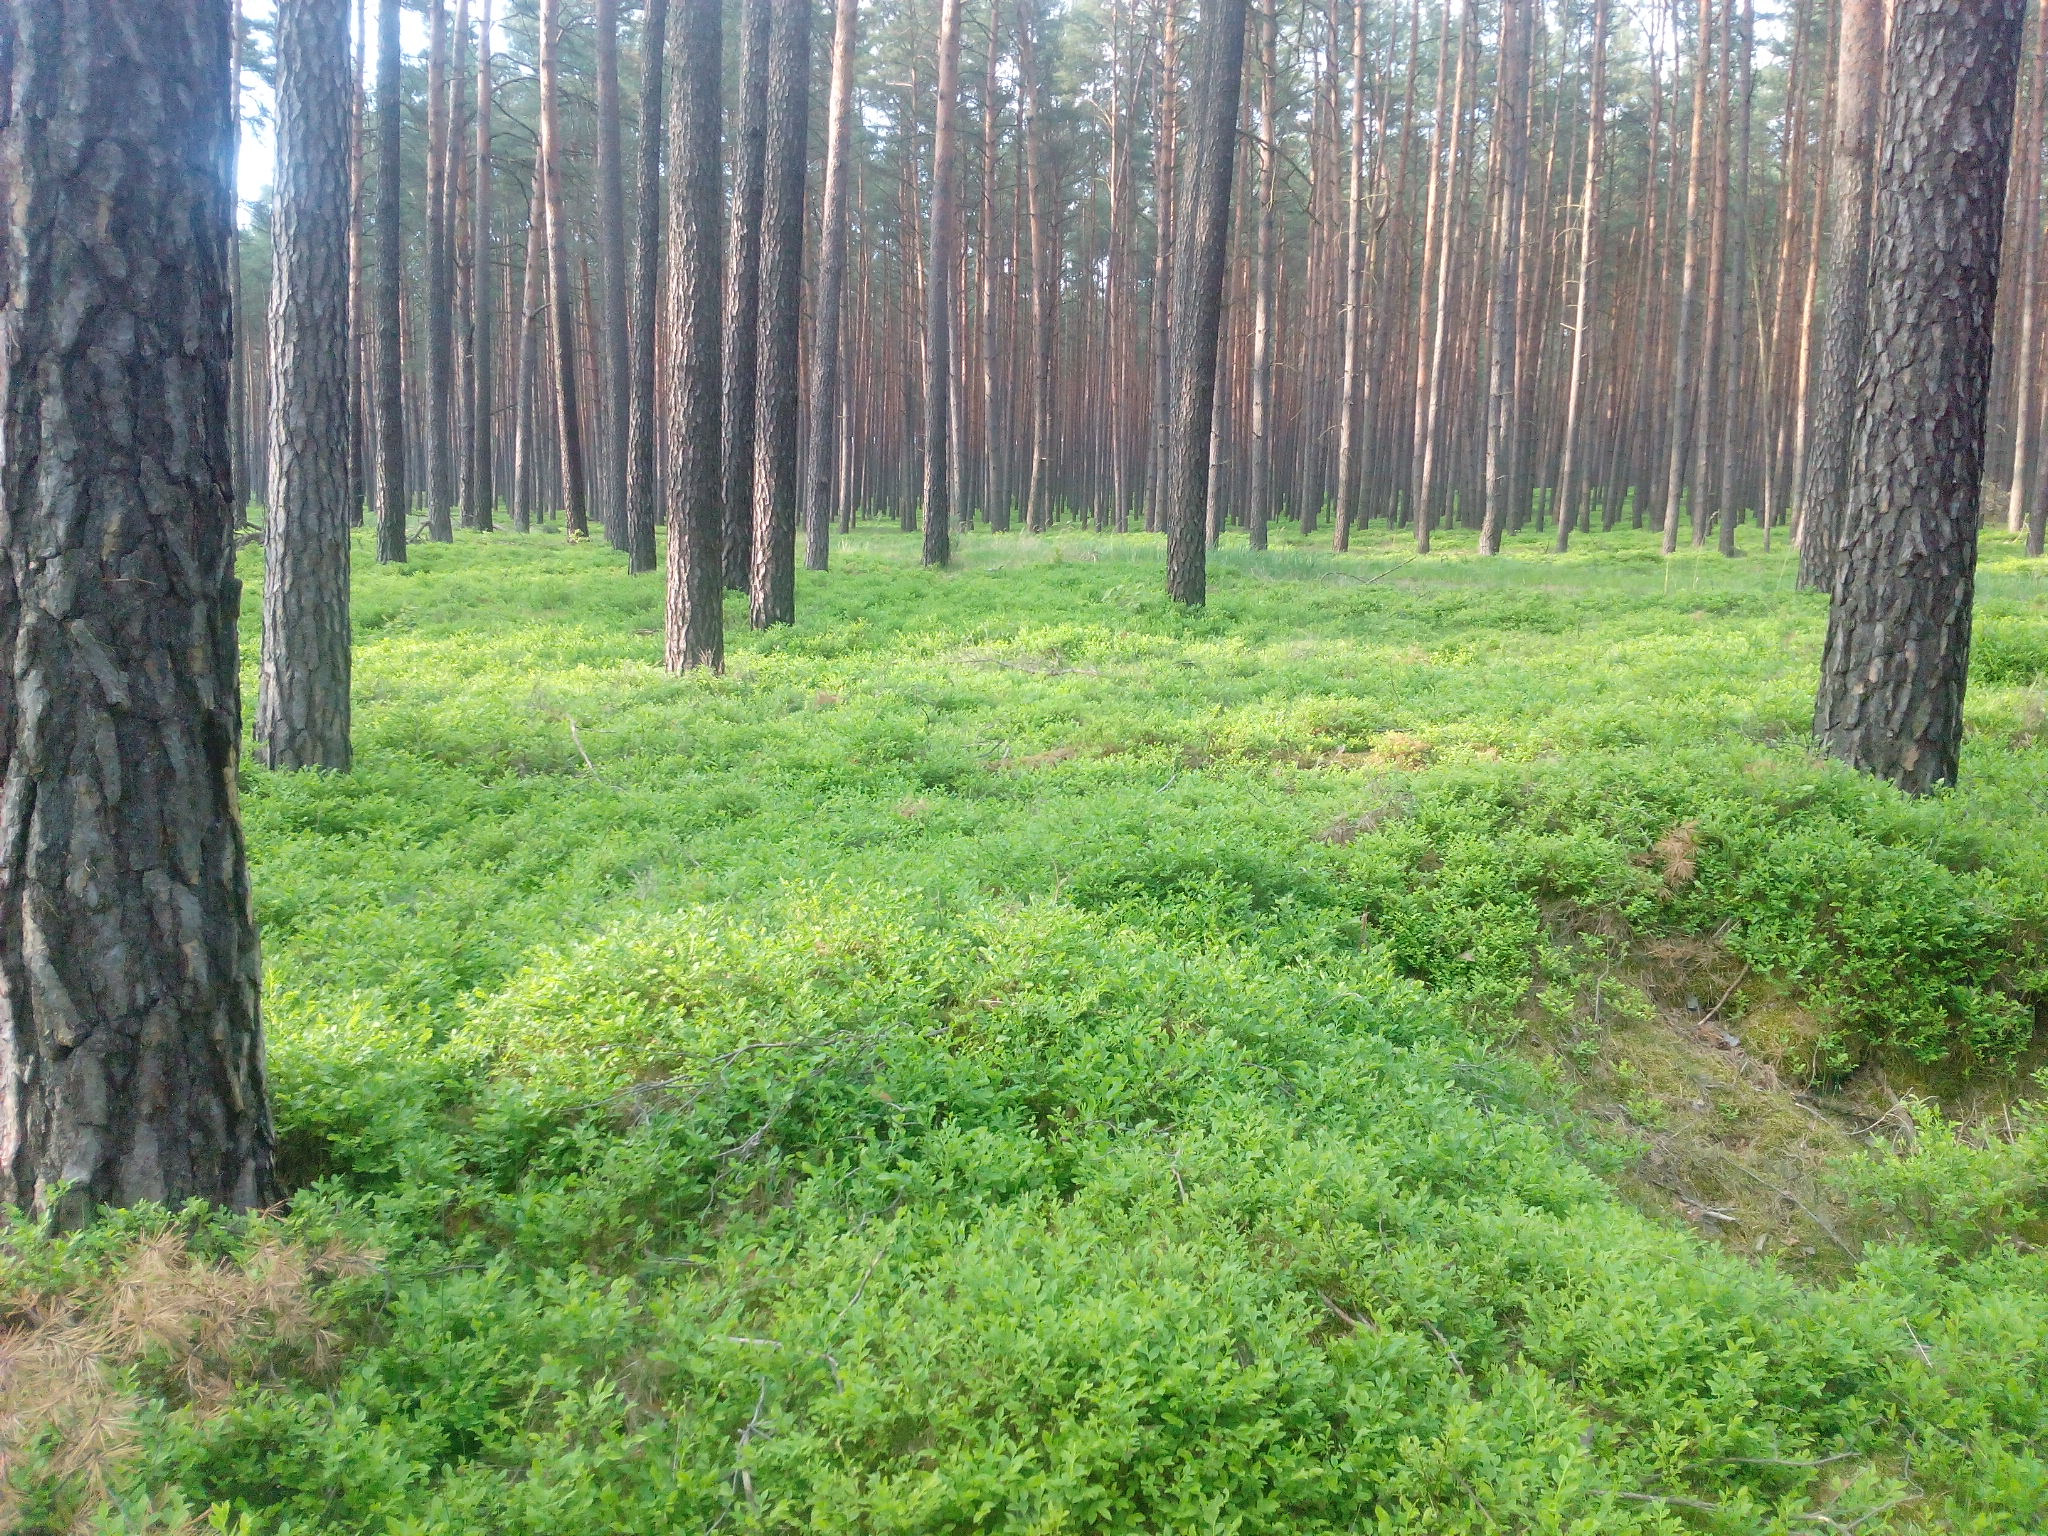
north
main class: Woodland
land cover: Pine dominated coniferous woodland
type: hemiboreal forest and nemoral coniferous forest and mixed broadleaved-coniferous forest
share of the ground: 25 - 50 %
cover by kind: coniferous forest trees 50 %, shrubs 50 %
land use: Forestry
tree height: > 5 m
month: May
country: DE
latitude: 52.9513
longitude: 13.6467
